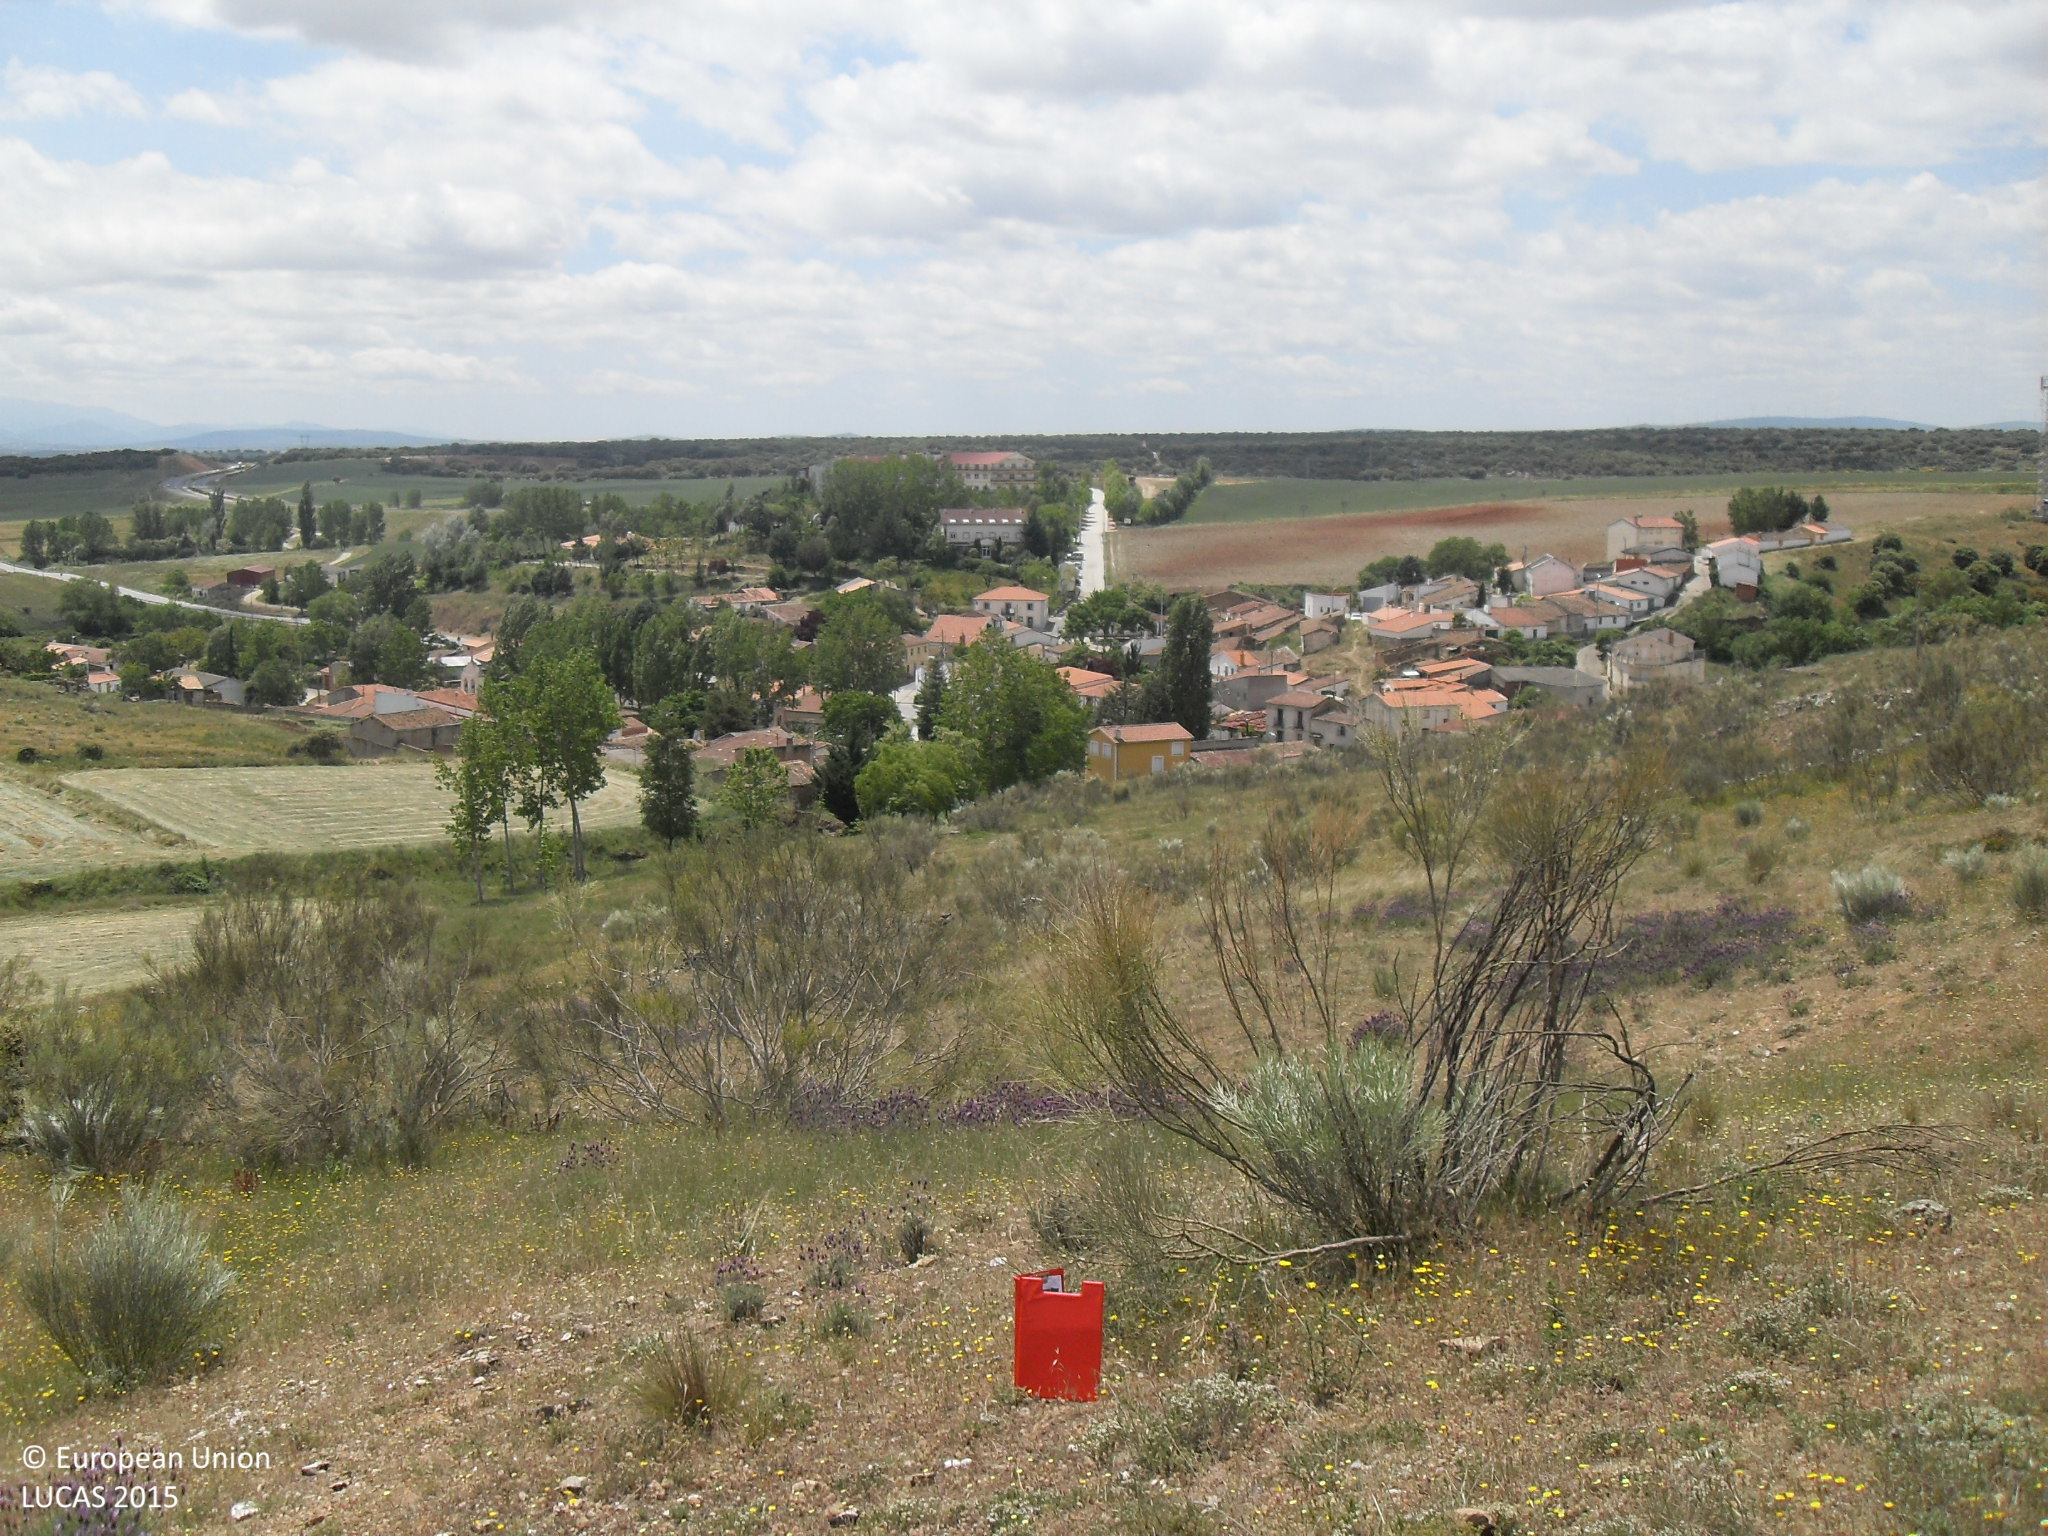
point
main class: Shrubland
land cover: Shrubland without tree cover
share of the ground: 10 - 25 %
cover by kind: herbaceous plants 80 %, shrubs 20 %
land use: Agriculture (excluding fallow land and kitchen gardens)
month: May
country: ES
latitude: 40.7531
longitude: -5.6251
